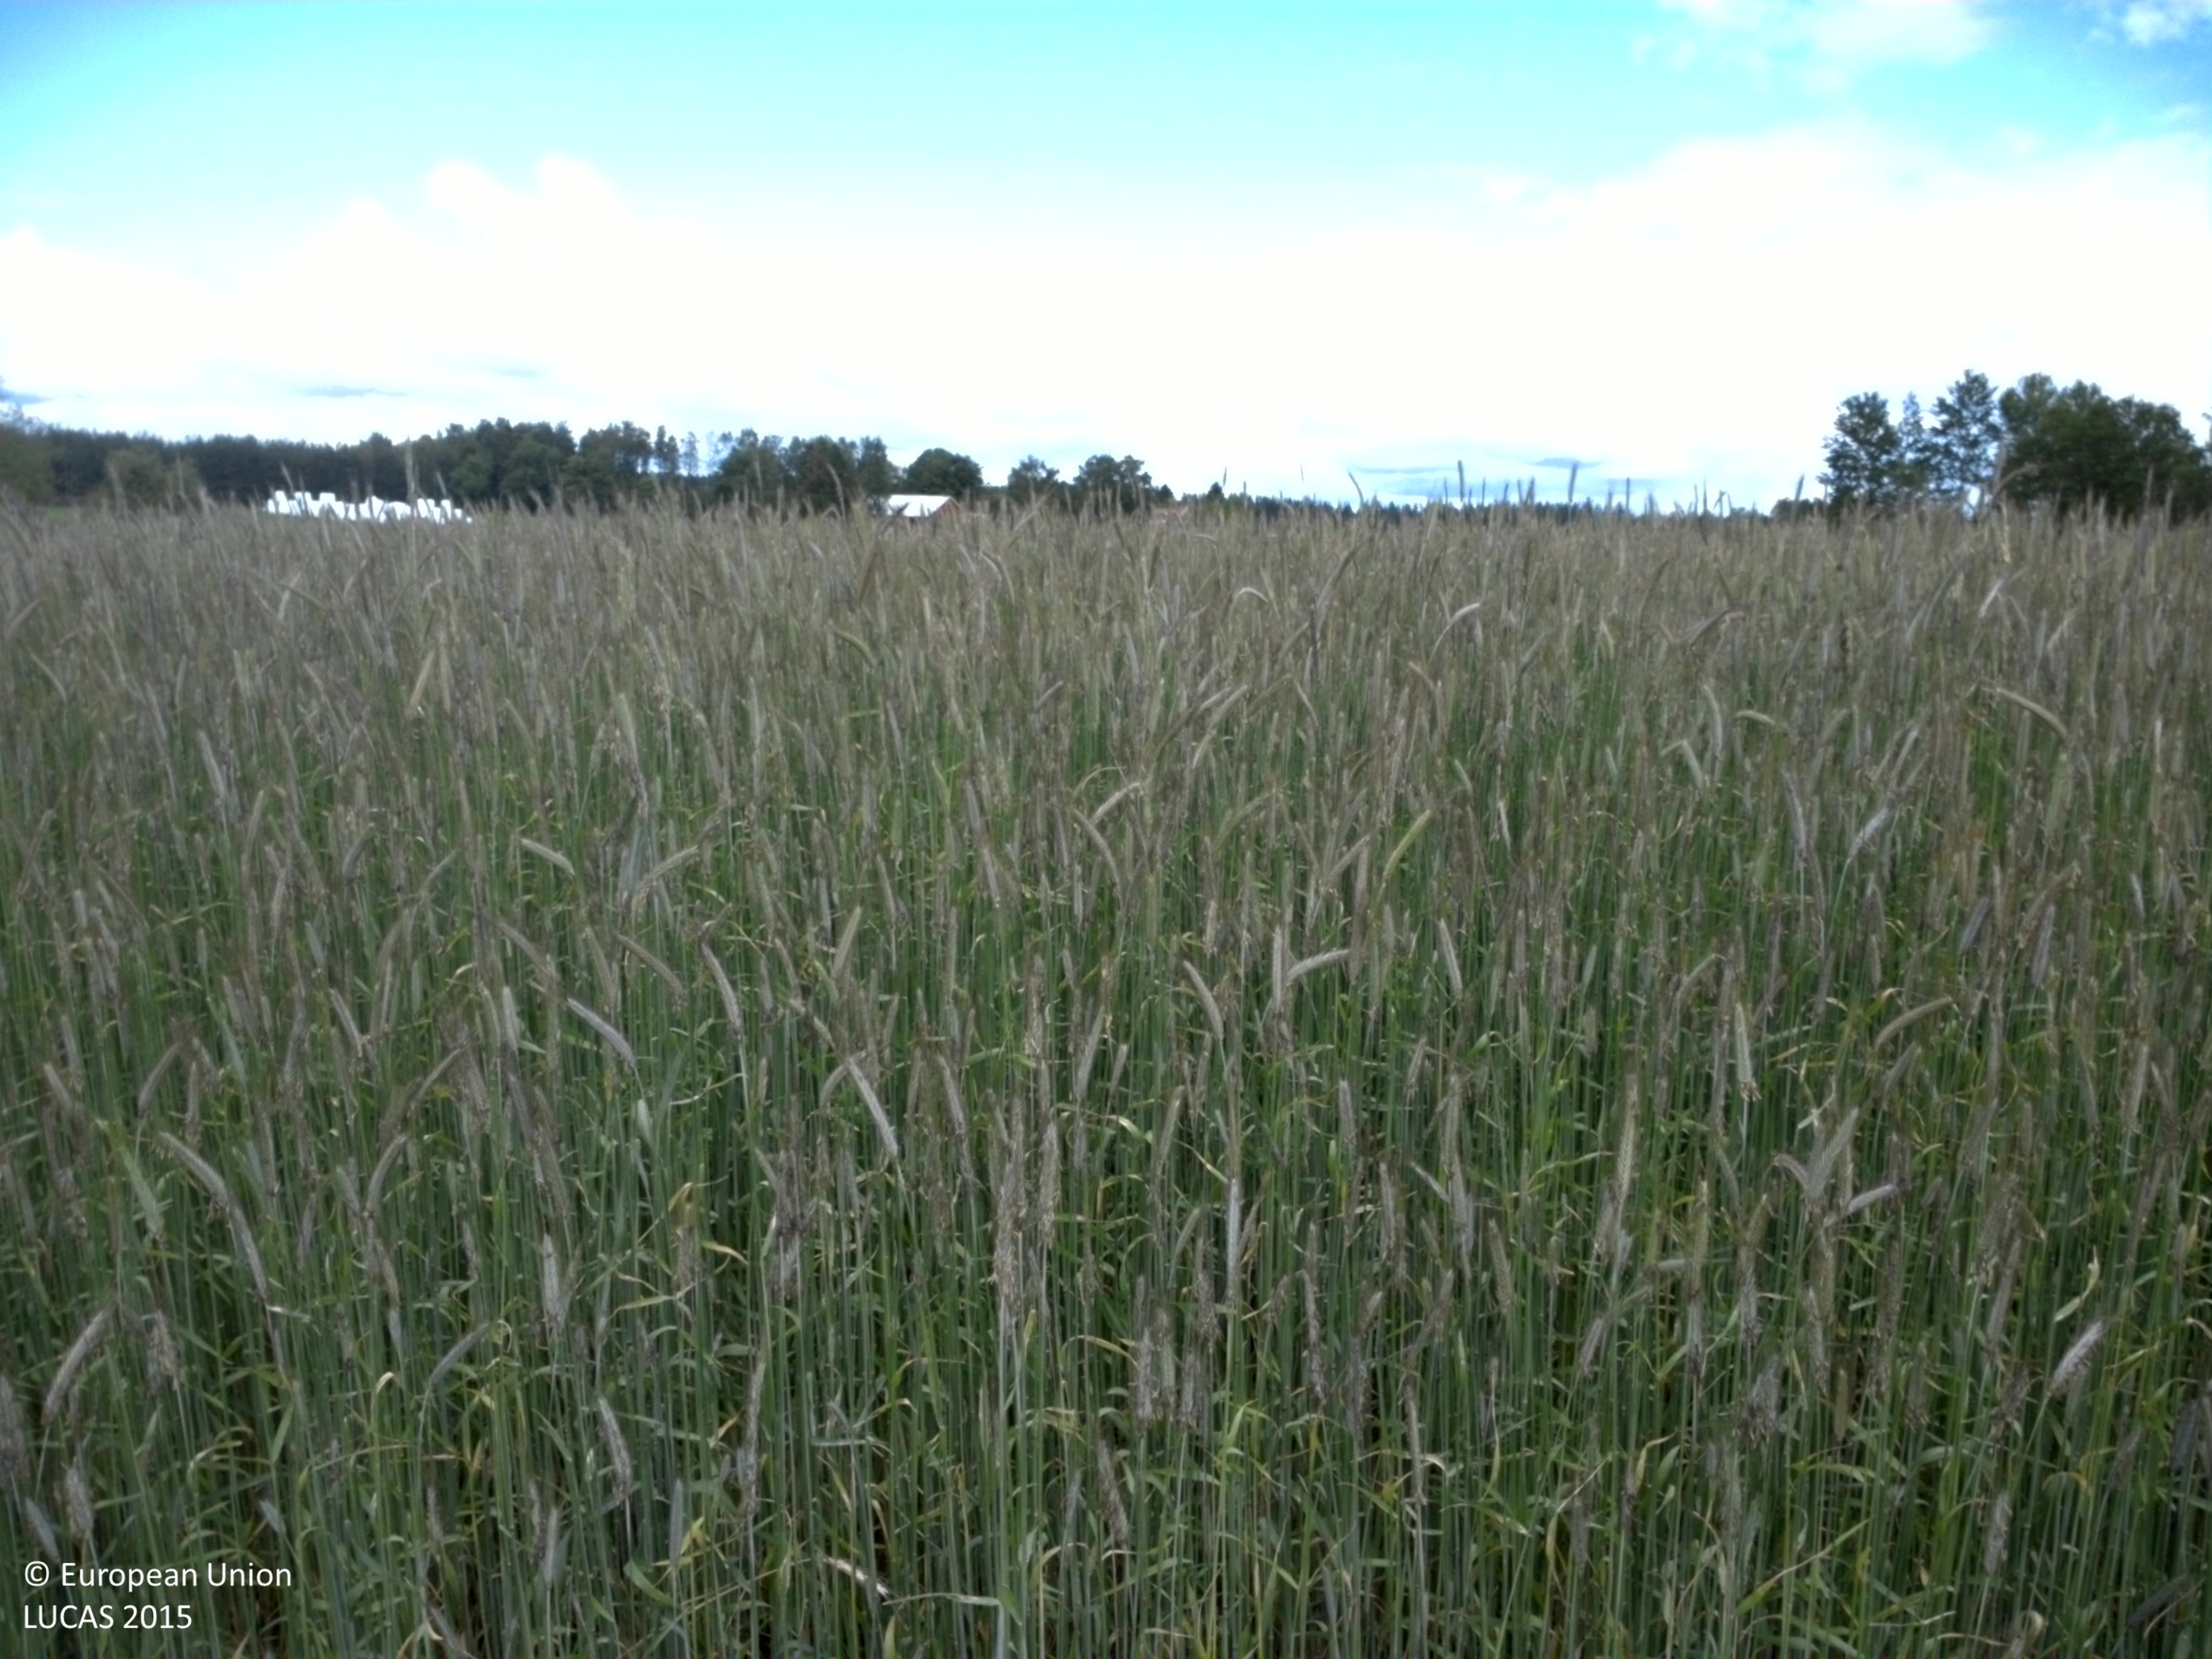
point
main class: Cropland
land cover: Rye
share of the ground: > 75 %
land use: Agriculture (excluding fallow land and kitchen gardens)
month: June
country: SE
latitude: 58.4539
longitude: 14.3977
